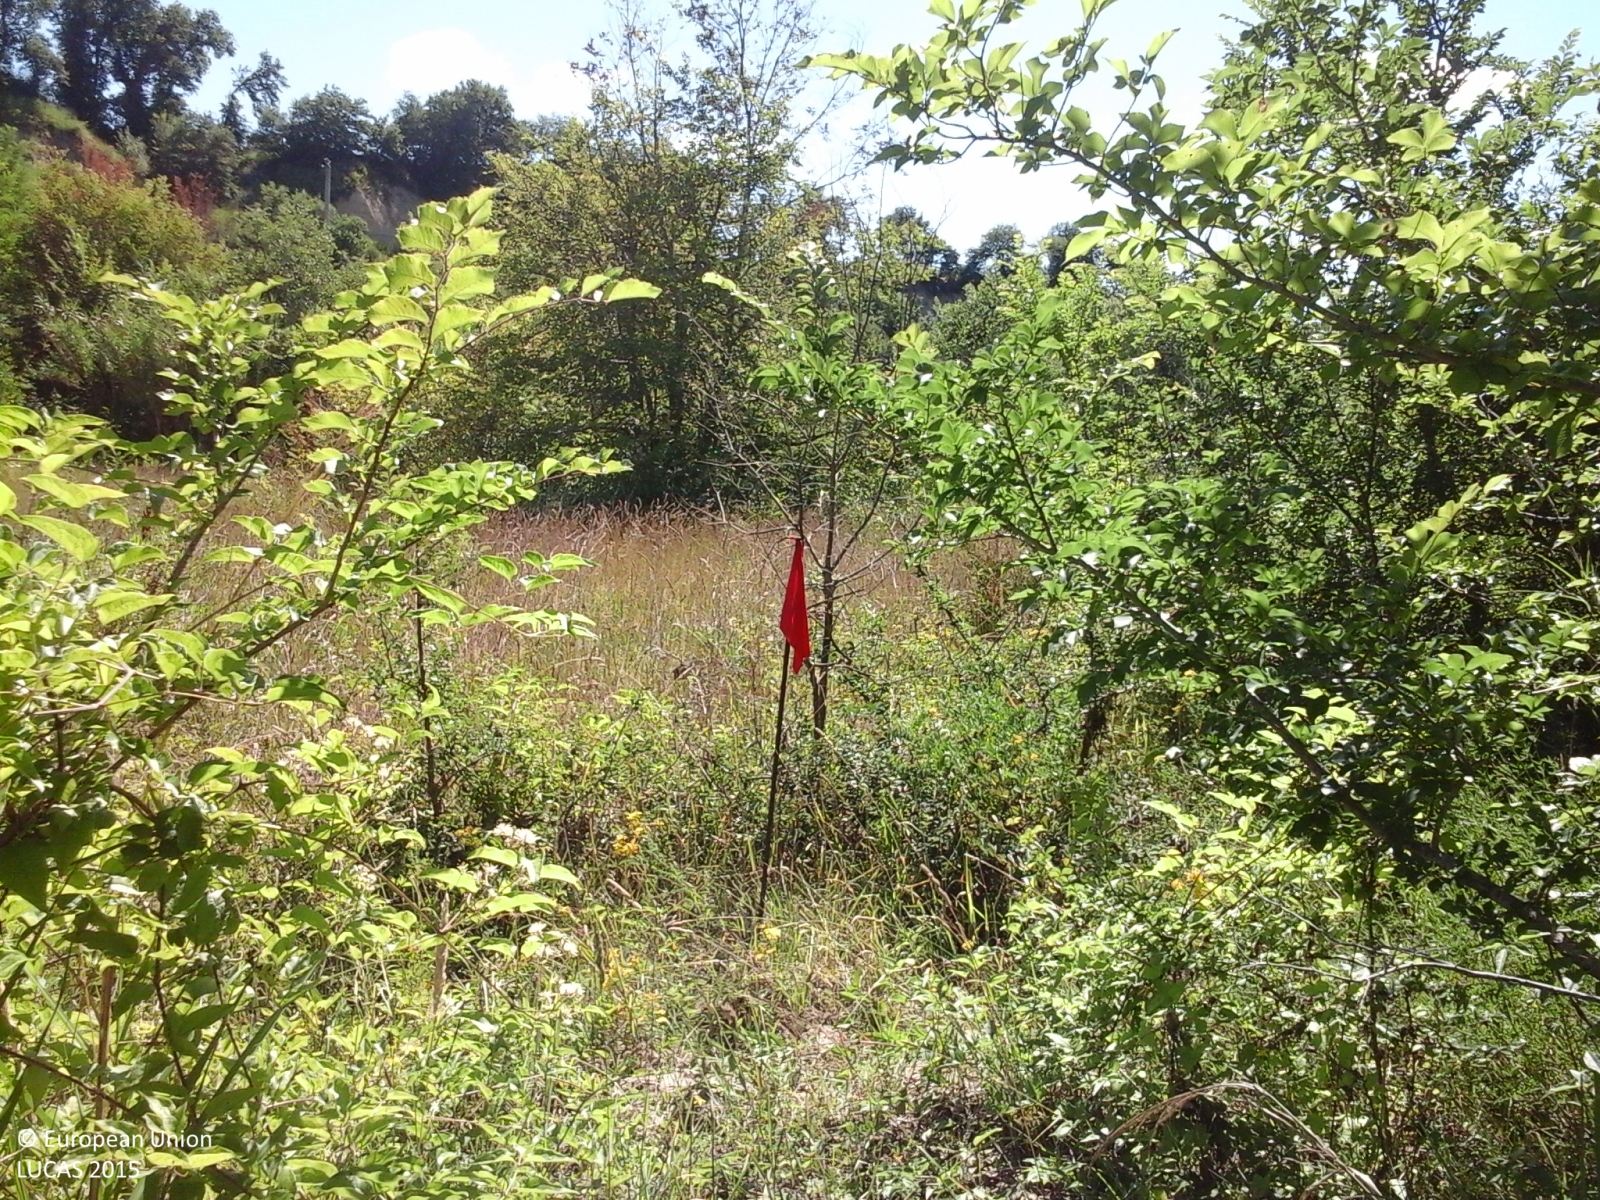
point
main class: Shrubland
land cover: Shrubland with sparse tree cover
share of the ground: > 75 %
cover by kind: shrubs 90 %, broadleaved forest trees 5 %, herbaceous plants 5 %
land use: Semi-natural and natural areas not in use
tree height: < 5 m
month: June
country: IT
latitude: 42.1284
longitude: 14.3051
